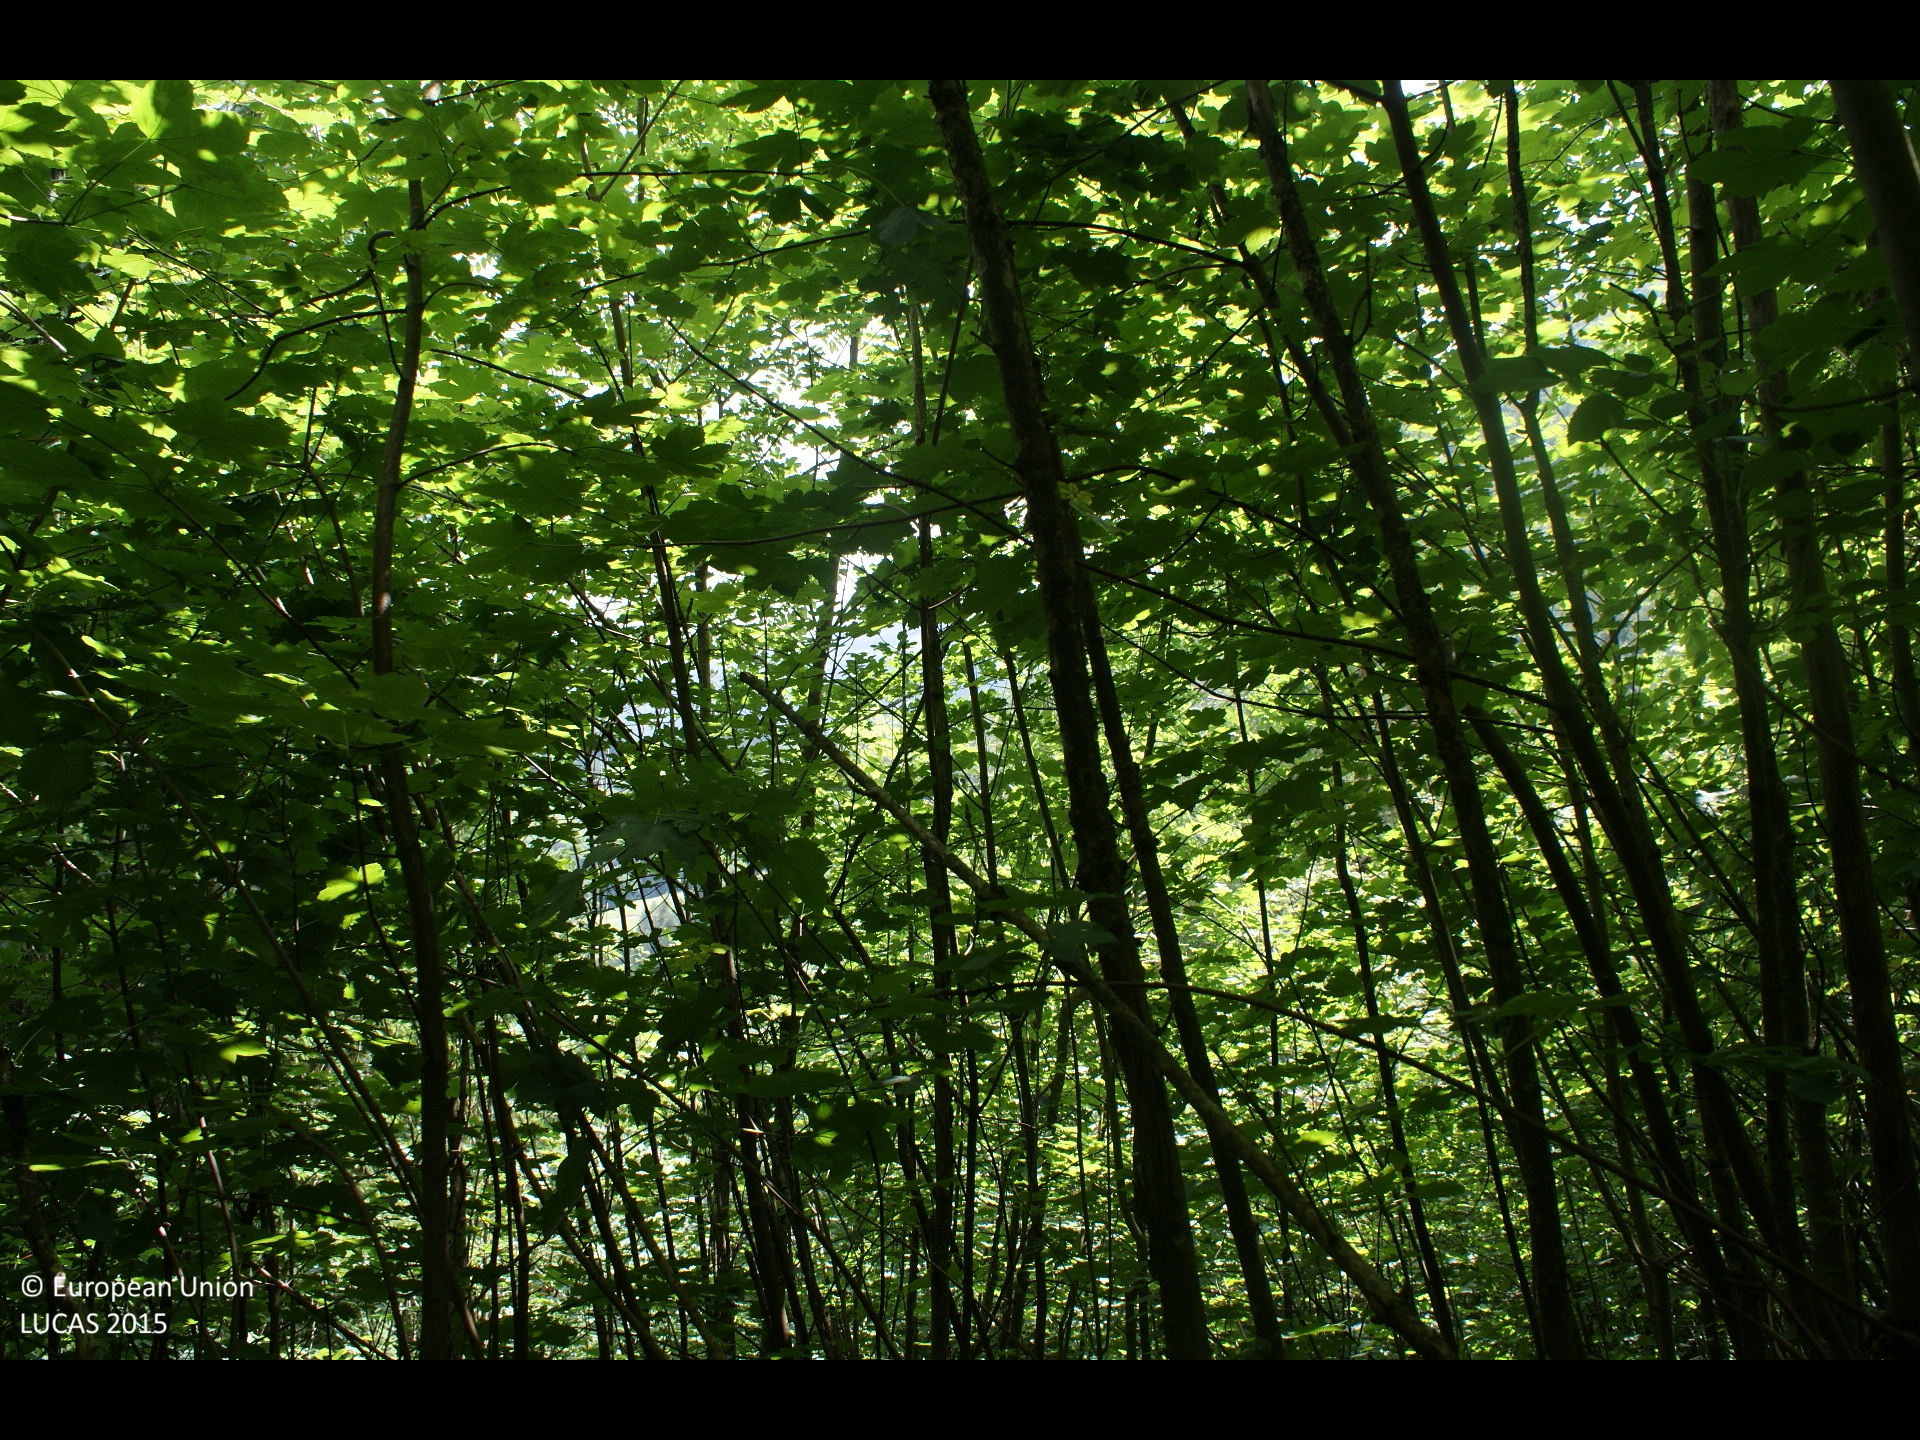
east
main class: Woodland
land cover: Broadleaved woodland
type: beech forest
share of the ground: > 75 %
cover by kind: broadleaved forest trees 90 %, coniferous forest trees 5 %, herbaceous plants 5 %
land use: Forestry
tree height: < 5 m
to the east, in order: Broadleaved woodland; Spruce dominated coniferous woodland; Grassland with sparse tree/shrub cover; Spruce dominated mixed woodland; Broadleaved woodland; Grassland with sparse tree/shrub cover; Broadleaved woodland; Tracks; Other mixed woodland; Rivers and streams; Spruce dominated mixed woodland
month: June
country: AT
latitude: 47.9405
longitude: 14.3238
